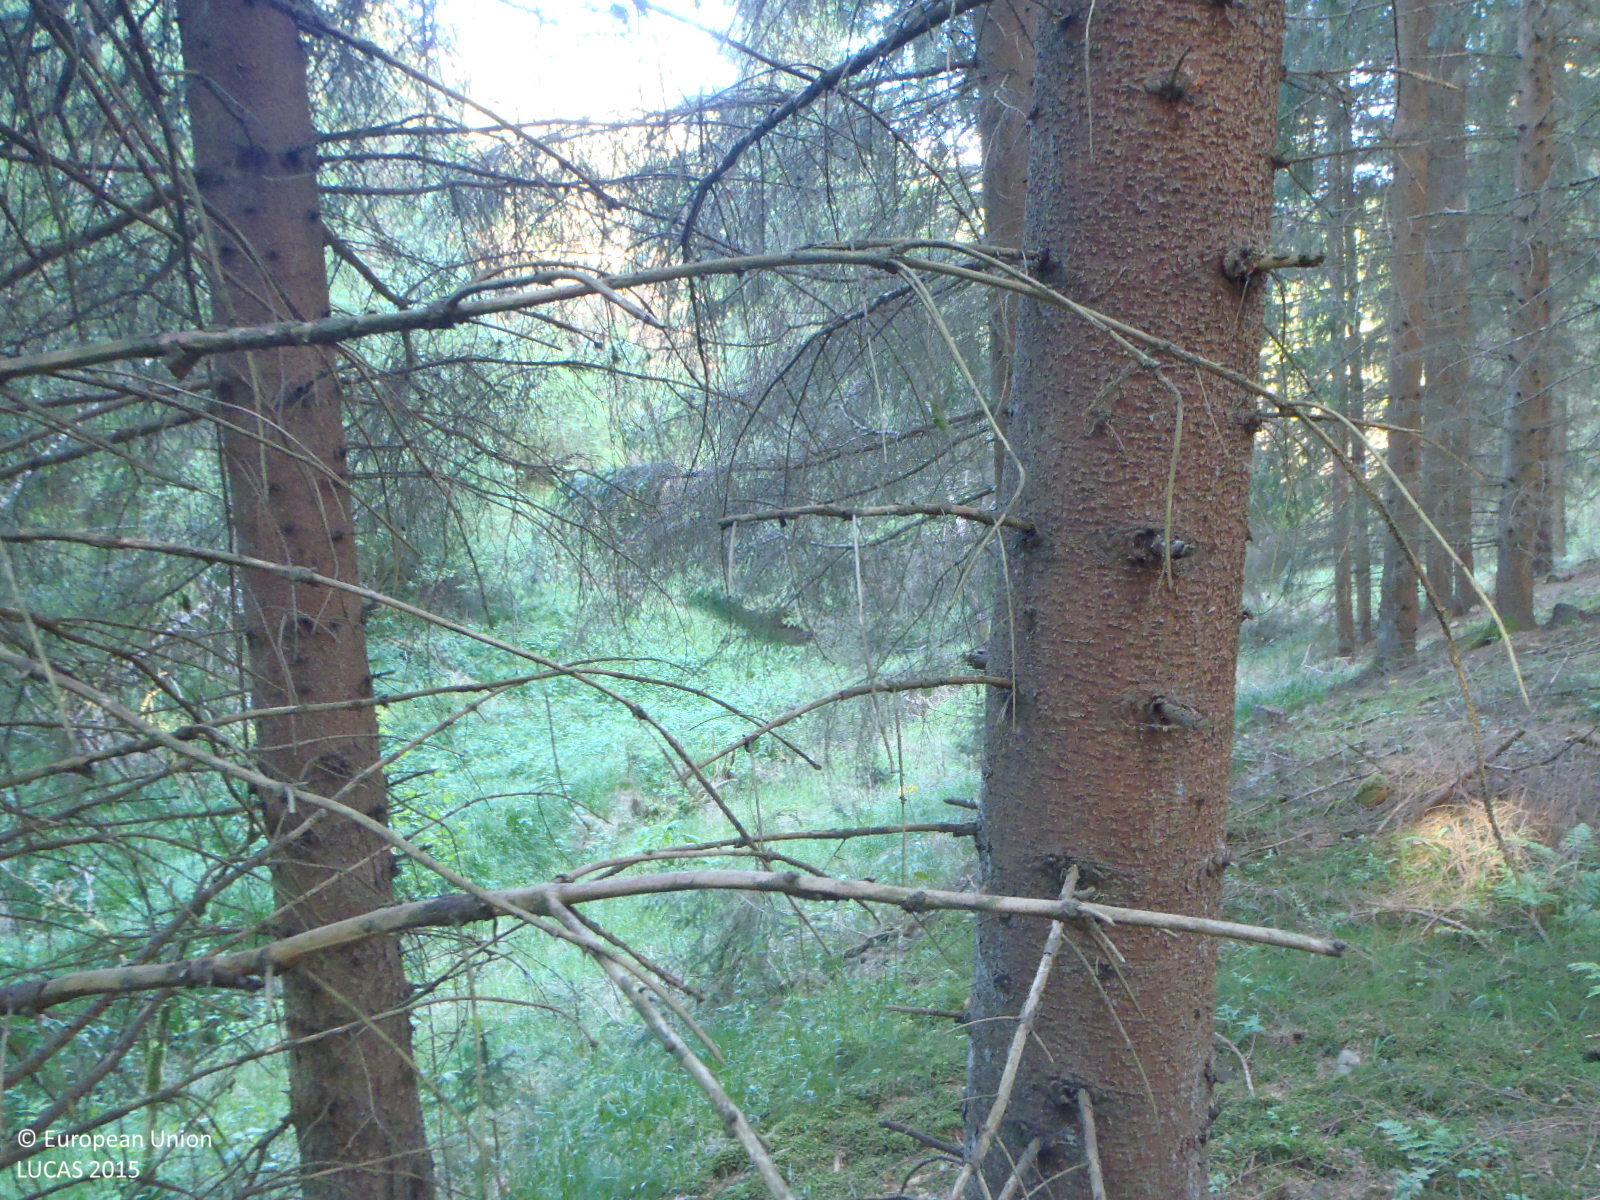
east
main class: Woodland
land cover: Spruce dominated coniferous woodland
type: hemiboreal forest and nemoral coniferous forest and mixed broadleaved-coniferous forest
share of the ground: > 75 %
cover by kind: coniferous forest trees 95 %, herbaceous plants 5 %
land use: Forestry
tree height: > 5 m
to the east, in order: Spruce dominated coniferous woodland; Spruce dominated mixed woodland; Ditches and canals; Other mixed woodland; Grassland with sparse tree/shrub cover; Broadleaved woodland; Rivers and streams; Broadleaved woodland; Spruce dominated mixed woodland
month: June
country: CZ
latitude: 48.5702
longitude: 14.3509
